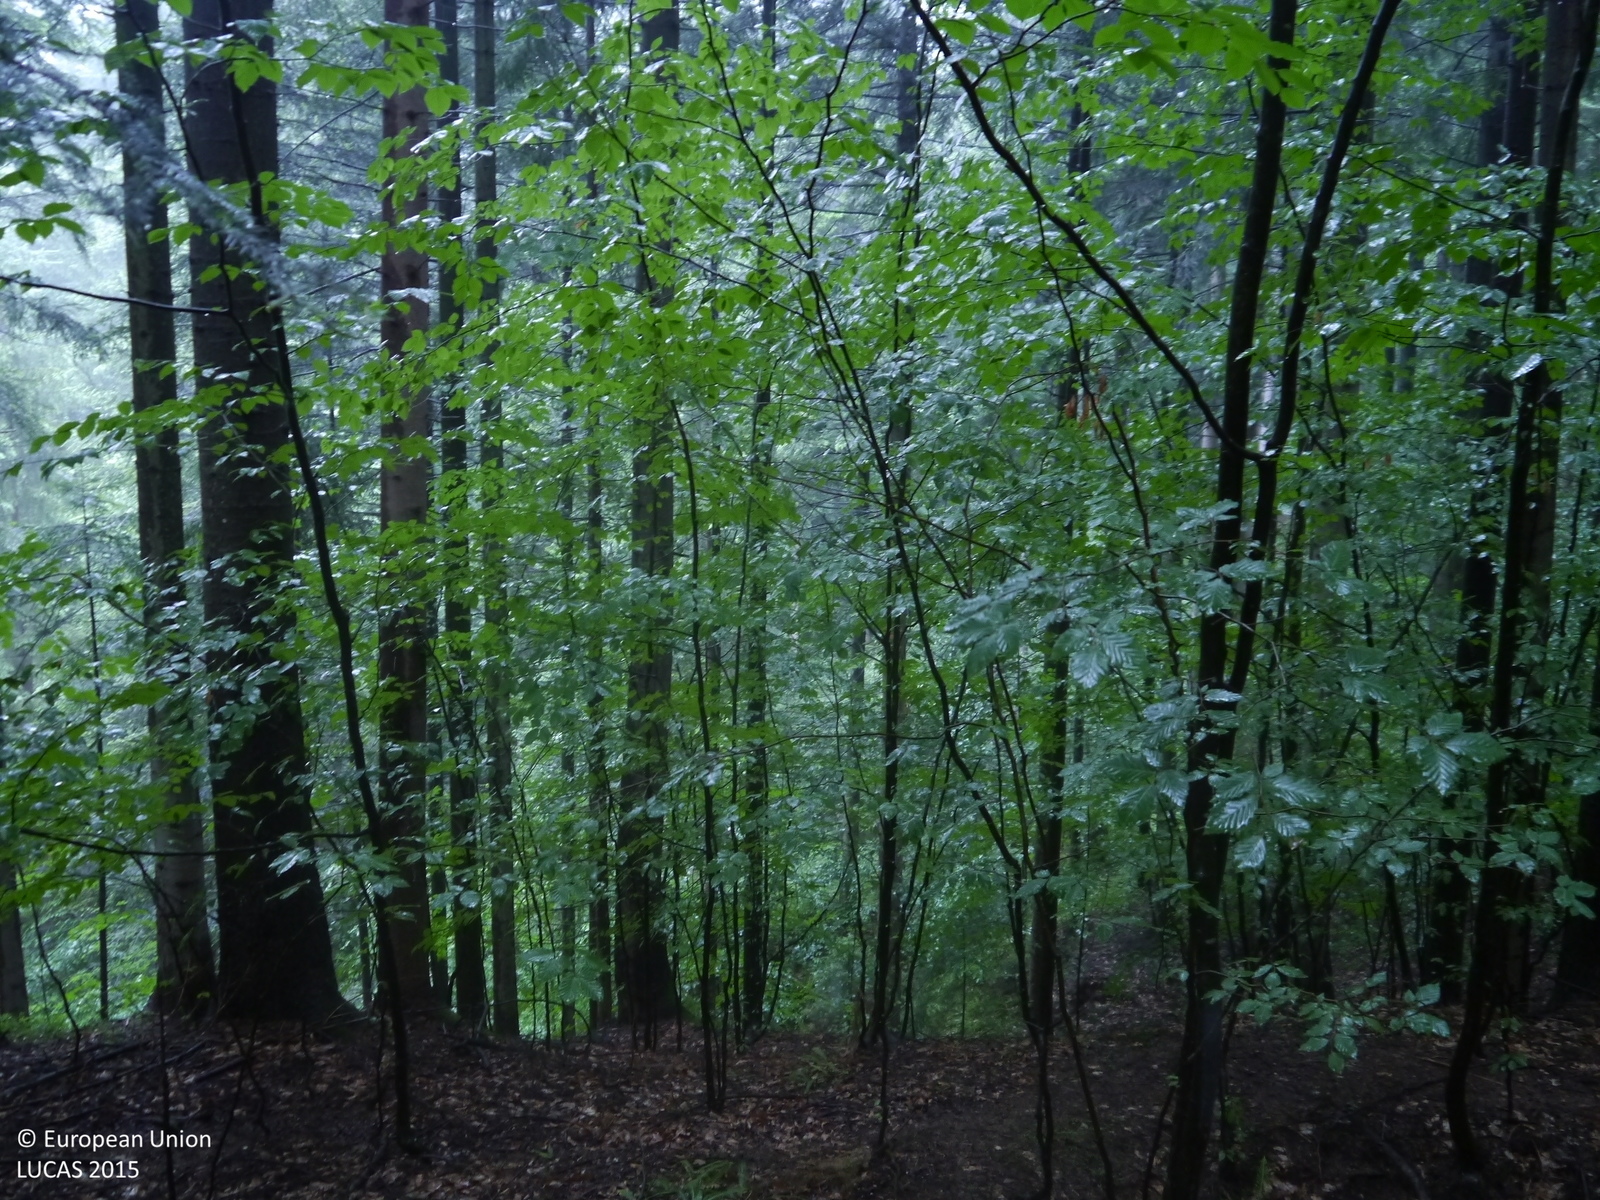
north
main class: Woodland
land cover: Spruce dominated mixed woodland
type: mountainous beech forest
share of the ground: > 75 %
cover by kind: coniferous forest trees 50 %, broadleaved forest trees 40 %, herbaceous plants 5 %, lichens and mosses 5 %
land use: Forestry
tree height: > 5 m
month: June
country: AT
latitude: 46.6932
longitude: 15.2162
